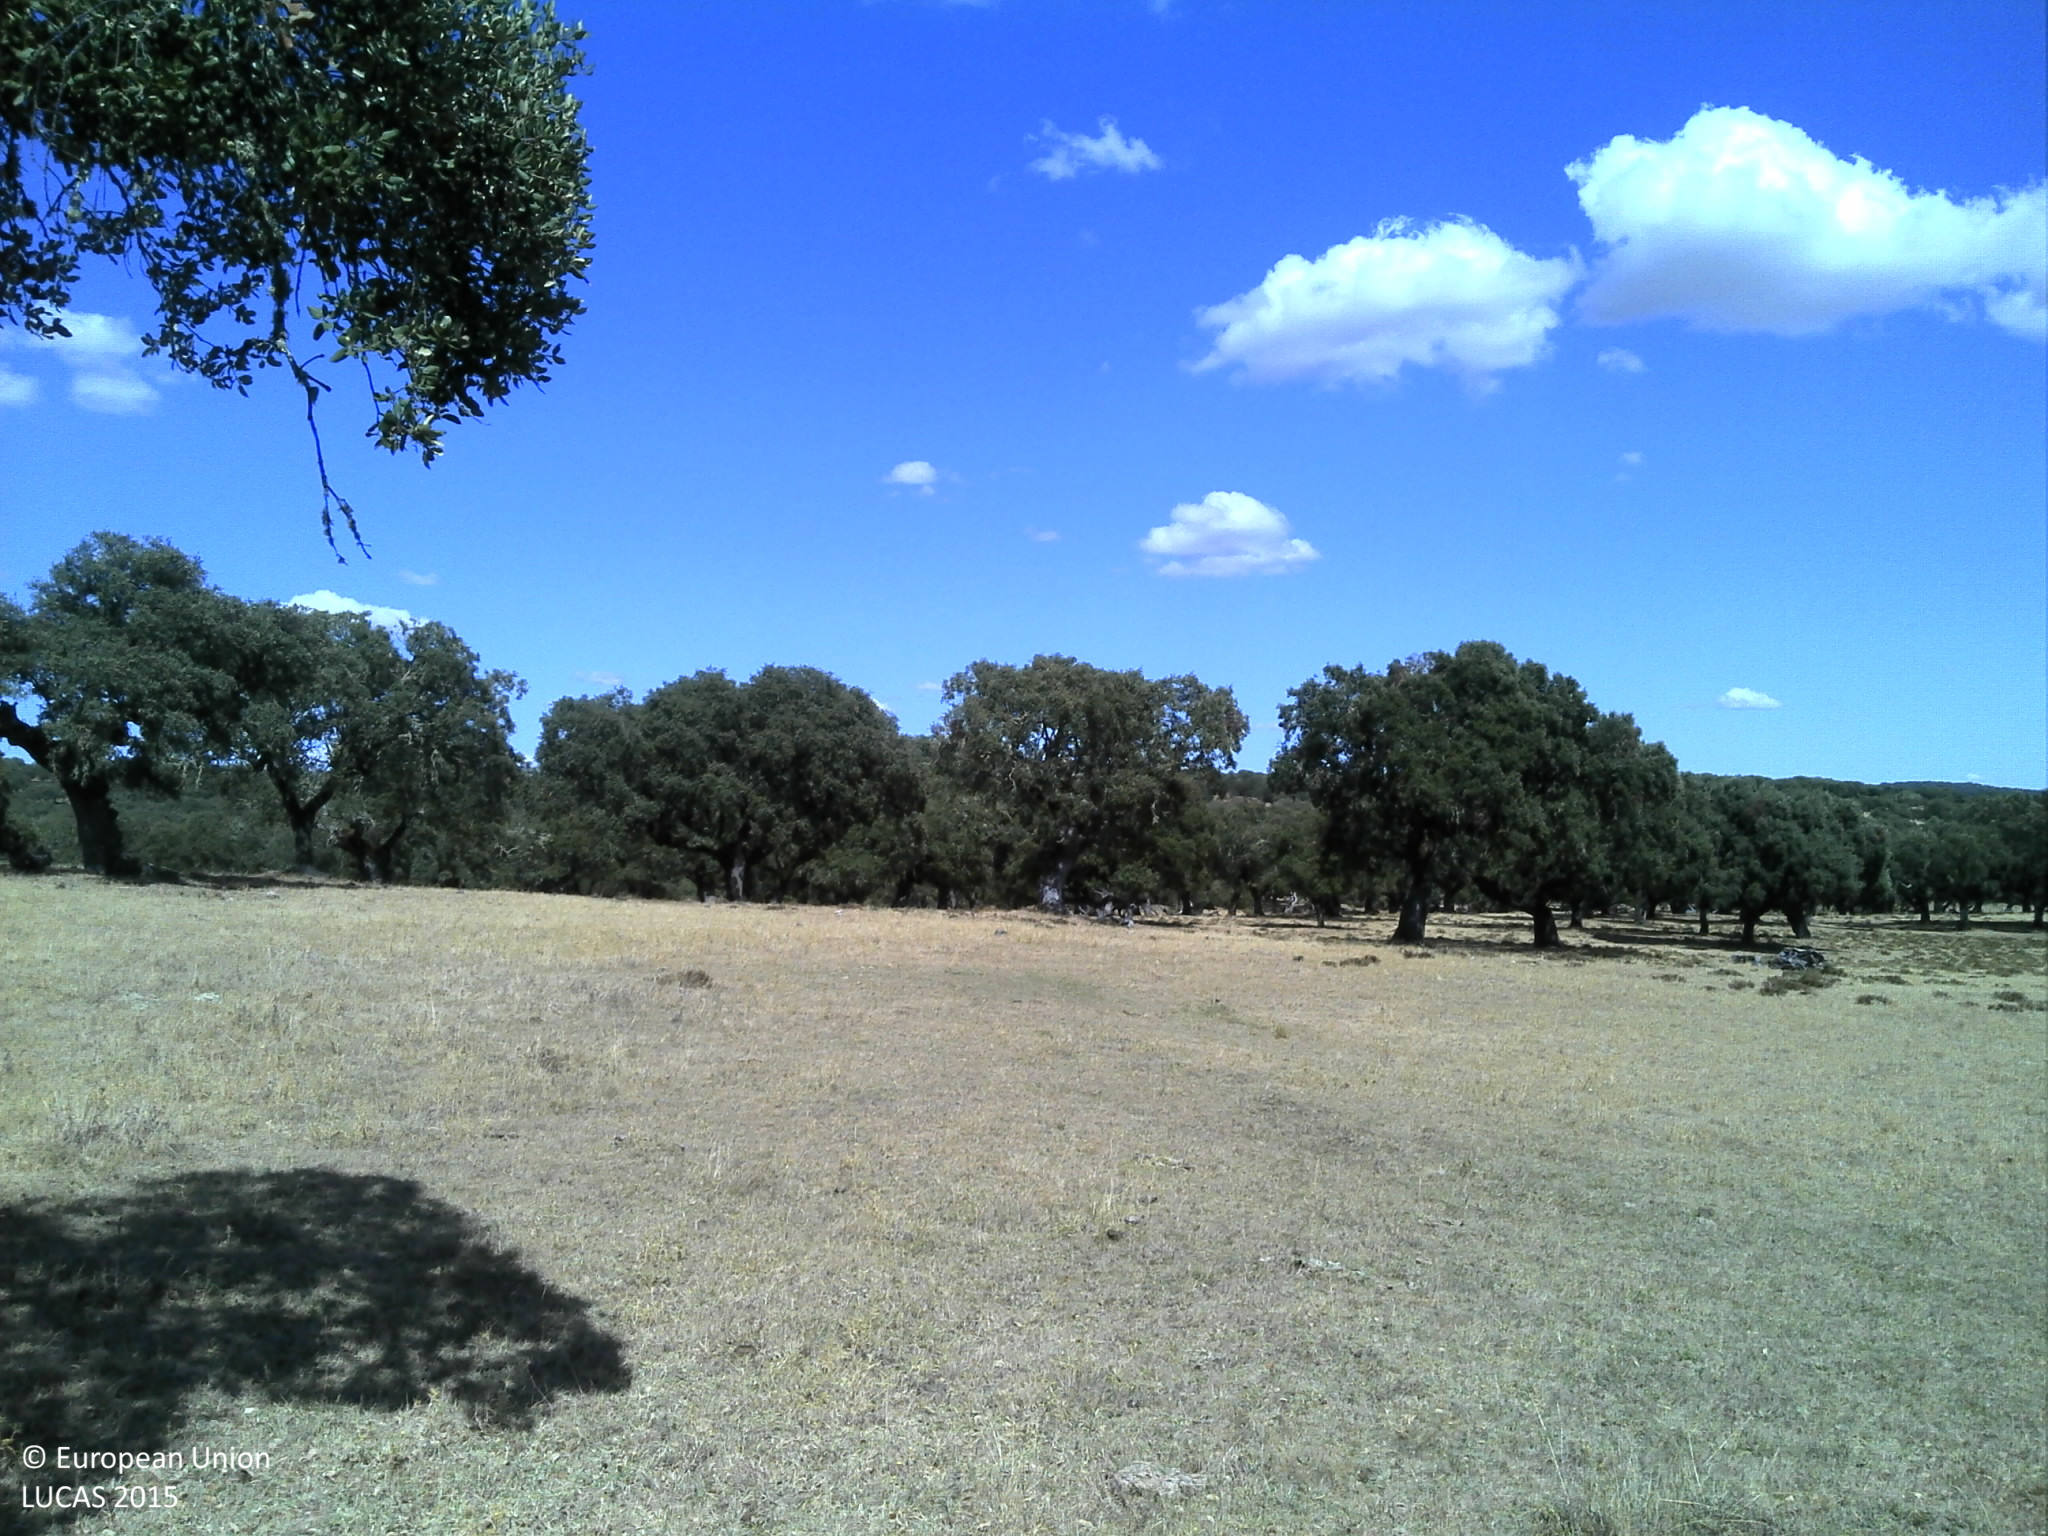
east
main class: Woodland
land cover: Broadleaved woodland
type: broadleaved evergreen forest
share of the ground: 10 - 25 %
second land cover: Grassland without tree/shrub cover
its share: 10 - 25 %
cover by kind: unconsolidated bare surface 70 %, broadleaved forest trees 15 %, herbaceous plants 15 %
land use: Forestry
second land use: Agriculture (excluding fallow land and kitchen gardens)
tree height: > 5 m
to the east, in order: Broadleaved woodland; Grassland without tree/shrub cover; Broadleaved woodland
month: July
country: PT
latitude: 39.1599
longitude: -7.5041
